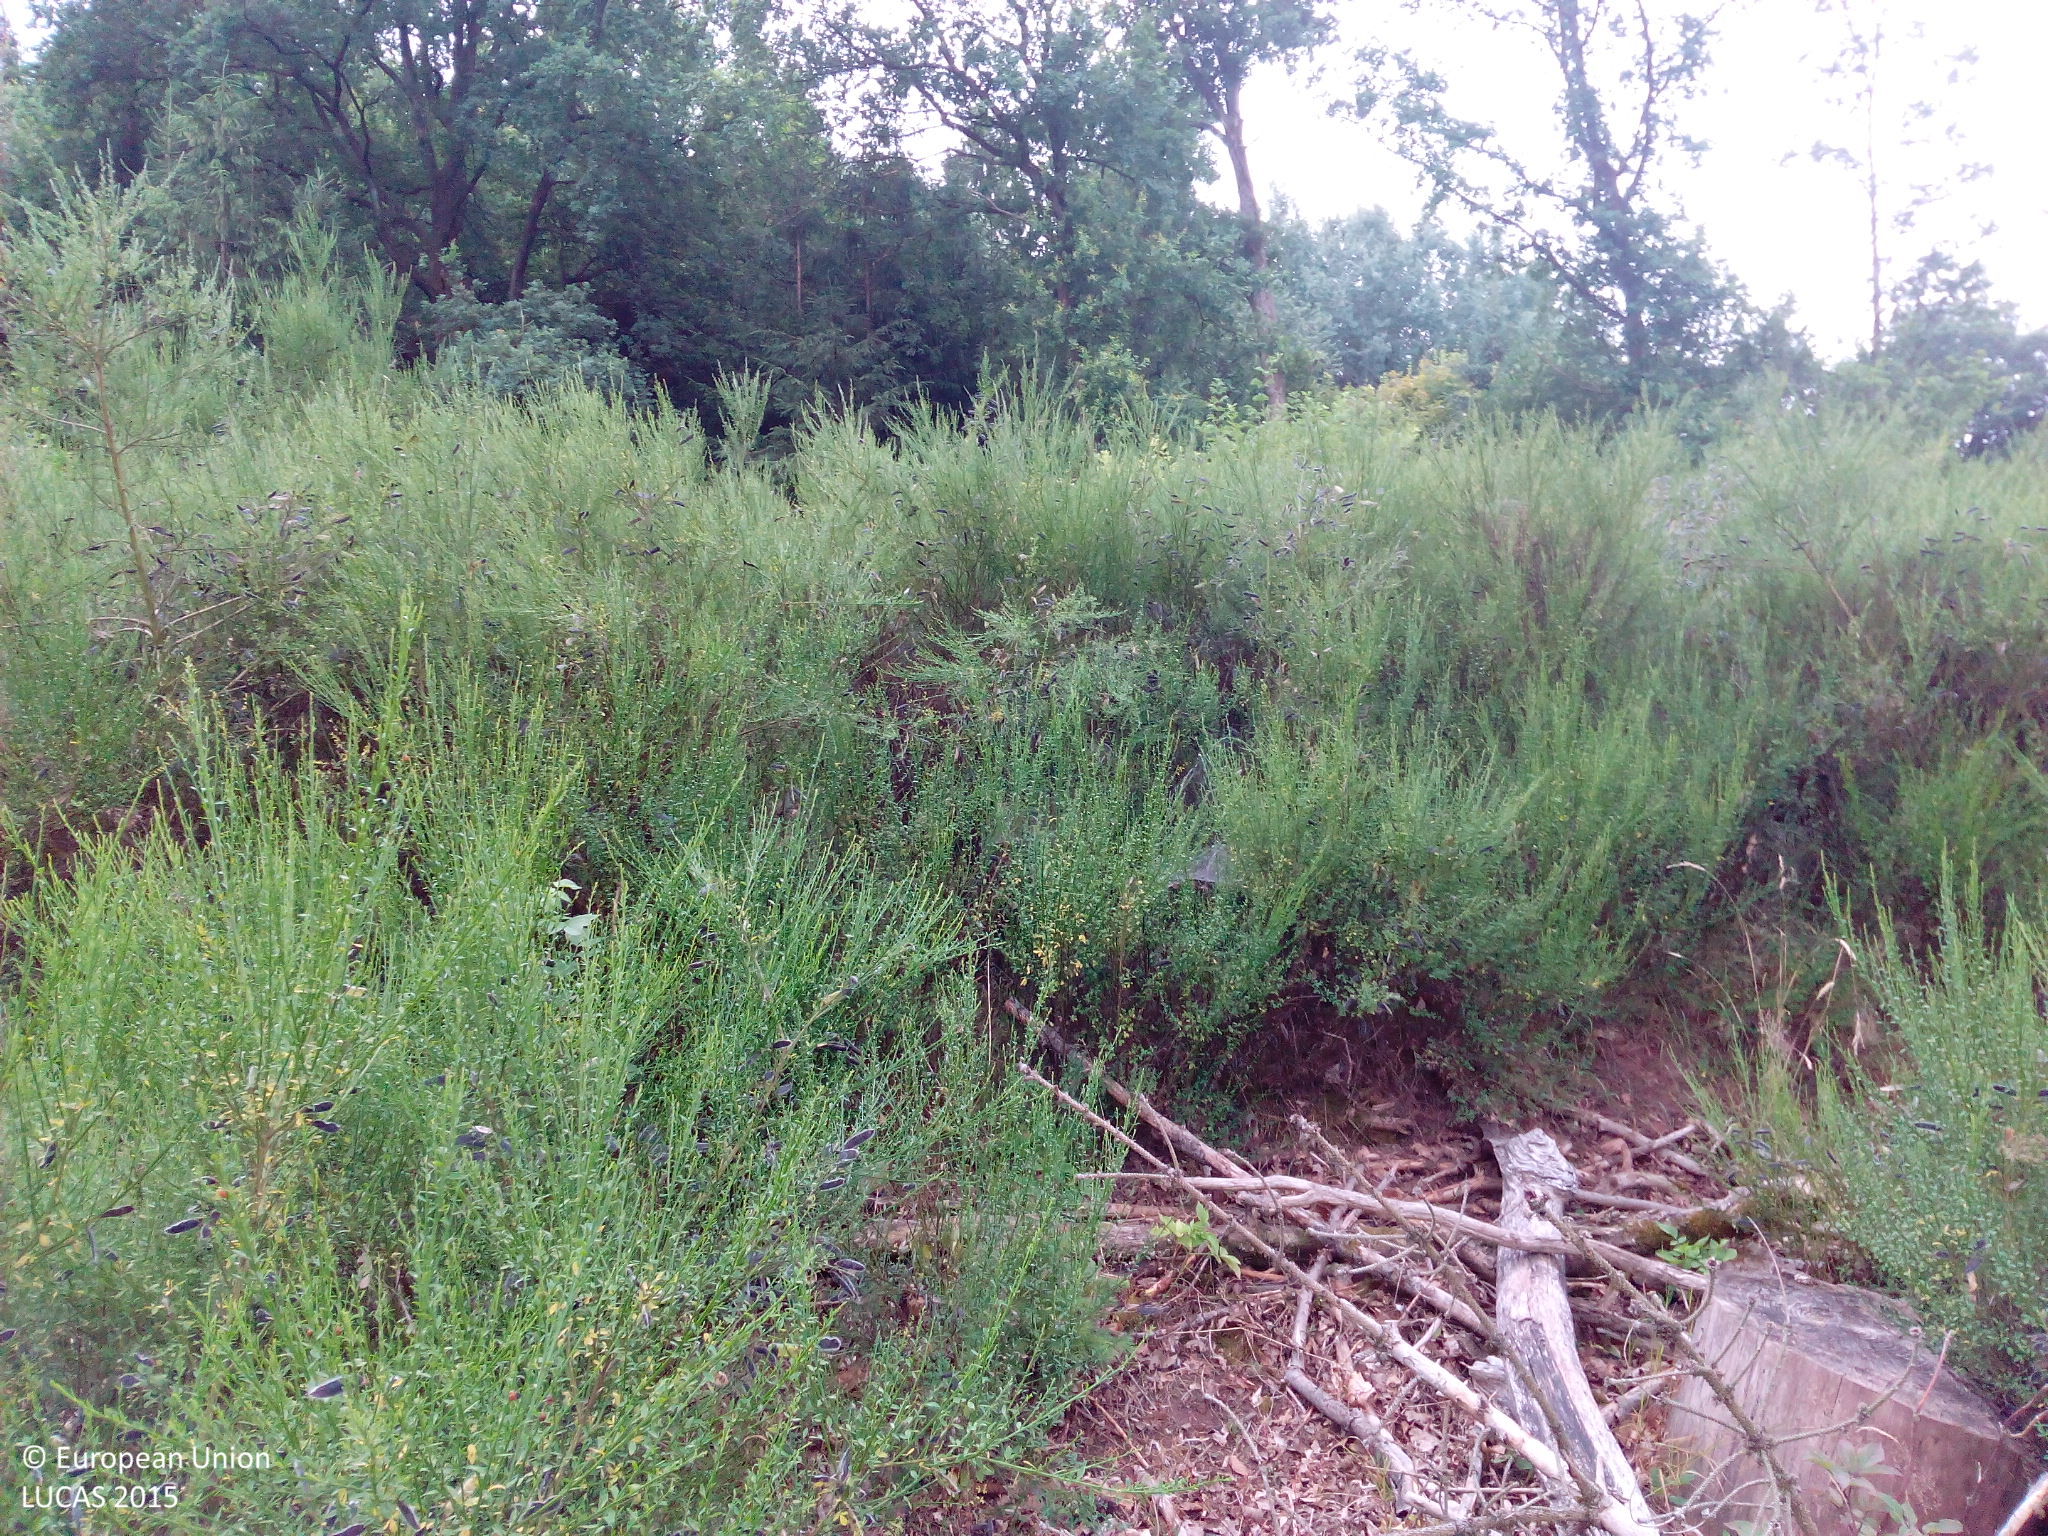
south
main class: Woodland
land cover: Broadleaved woodland
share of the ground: > 75 %
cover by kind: broadleaved forest trees 85 %, shrubs 10 %, herbaceous plants 5 %
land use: Forestry
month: July
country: DE
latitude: 49.5006
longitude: 7.1420
